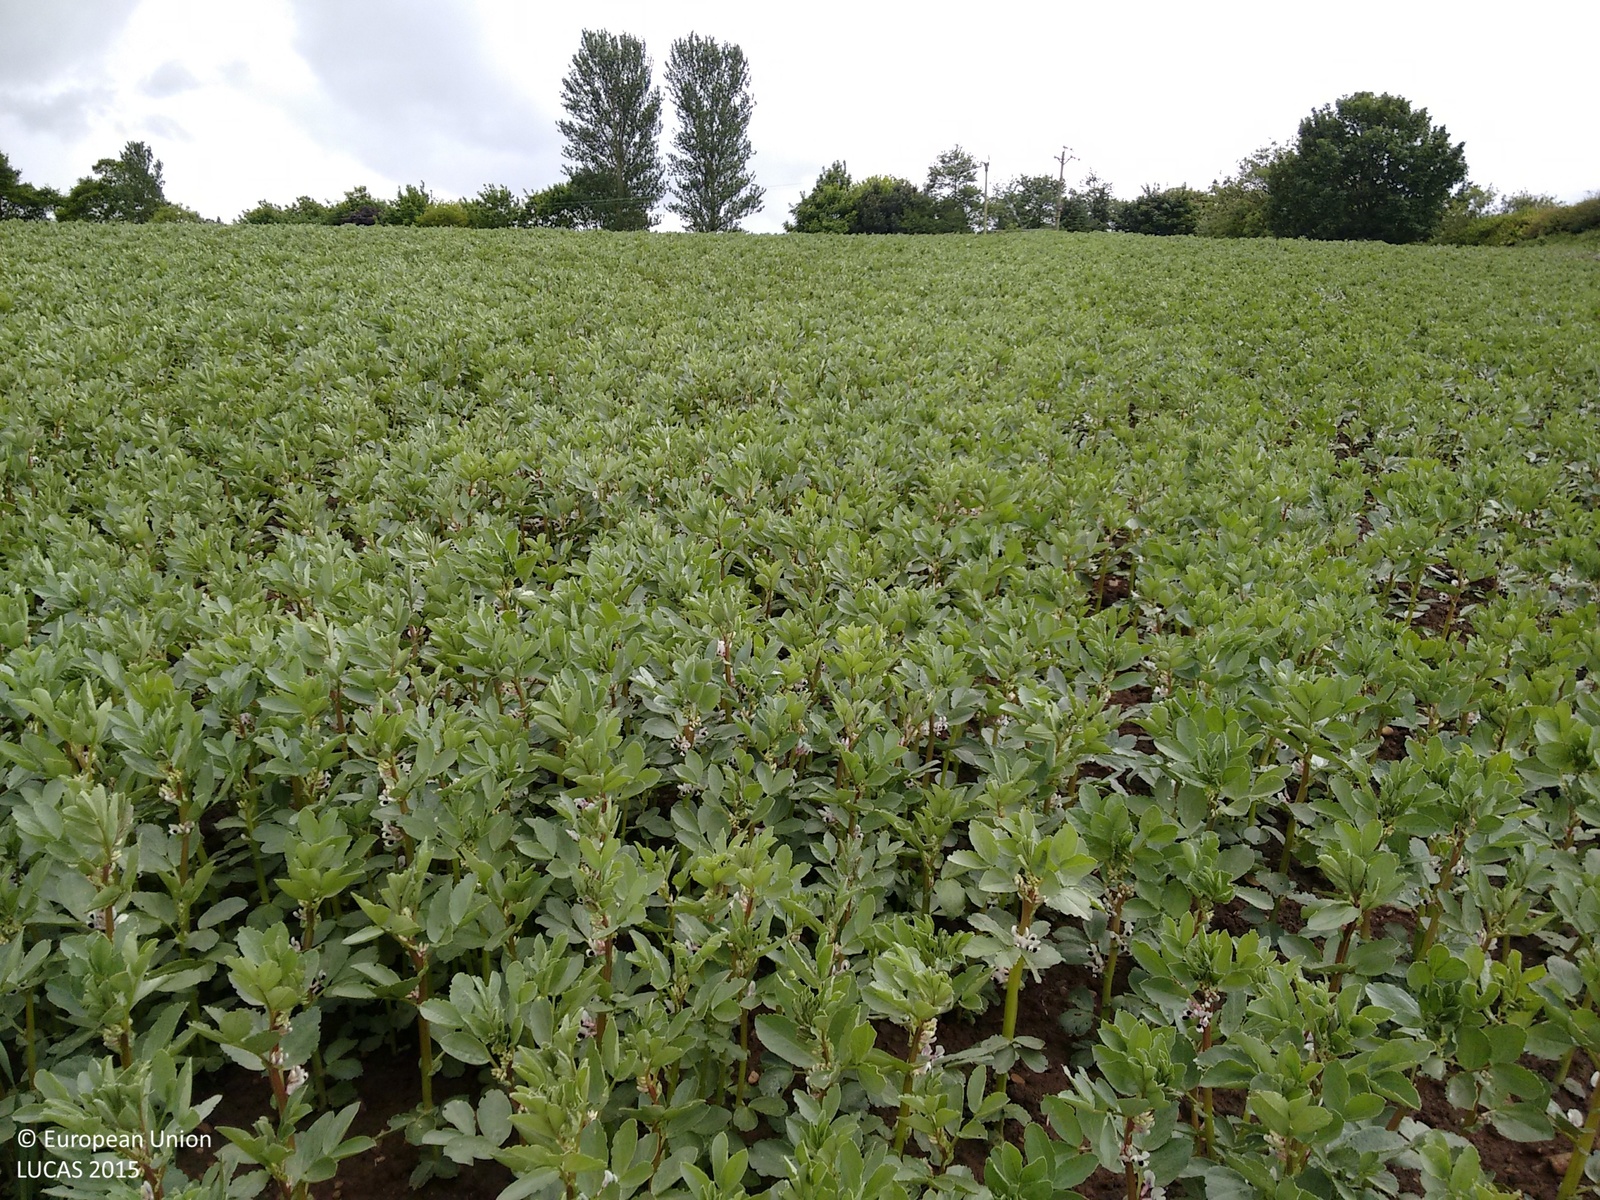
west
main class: Cropland
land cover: Dry pulses
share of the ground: > 75 %
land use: Agriculture (excluding fallow land and kitchen gardens)
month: June
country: GB
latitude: 54.0811
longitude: -1.3740
